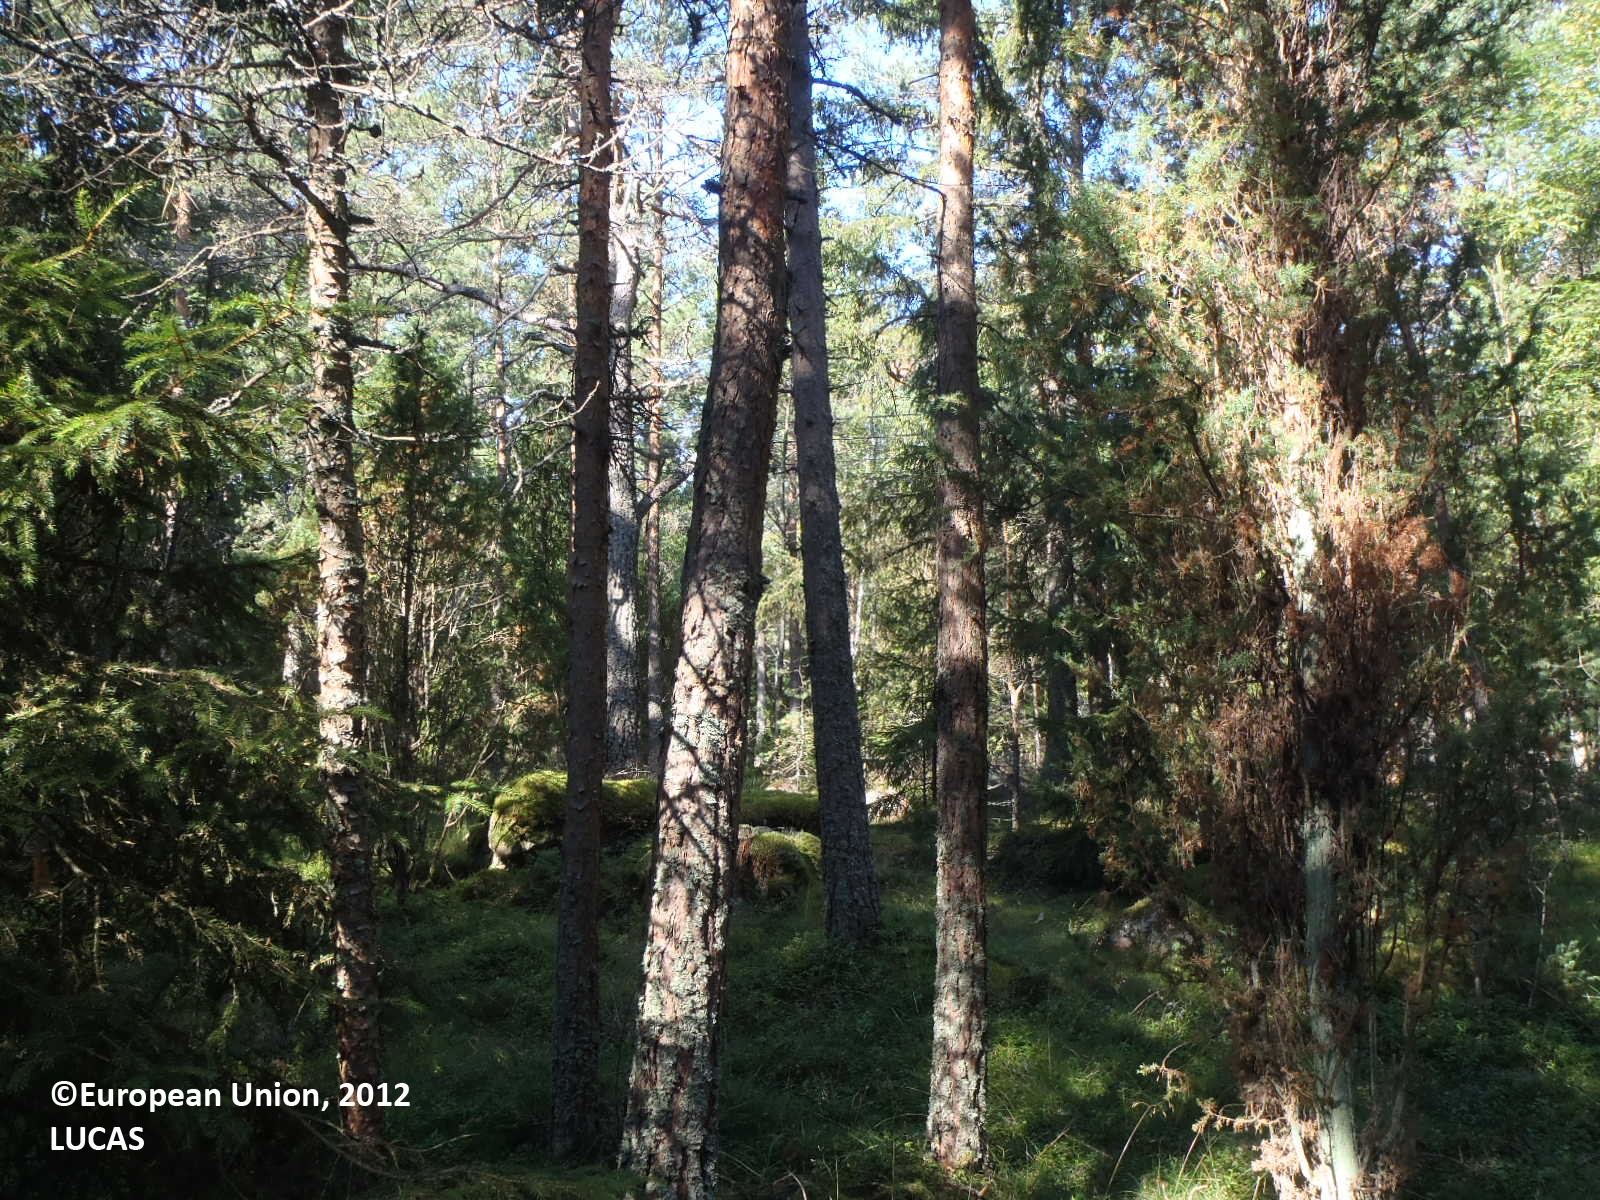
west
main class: Woodland
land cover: Pine dominated coniferous woodland
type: hemiboreal forest and nemoral coniferous forest and mixed broadleaved-coniferous forest
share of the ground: > 75 %
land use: Forestry
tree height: > 5 m
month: August
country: FI
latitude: 60.3622
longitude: 20.1044
